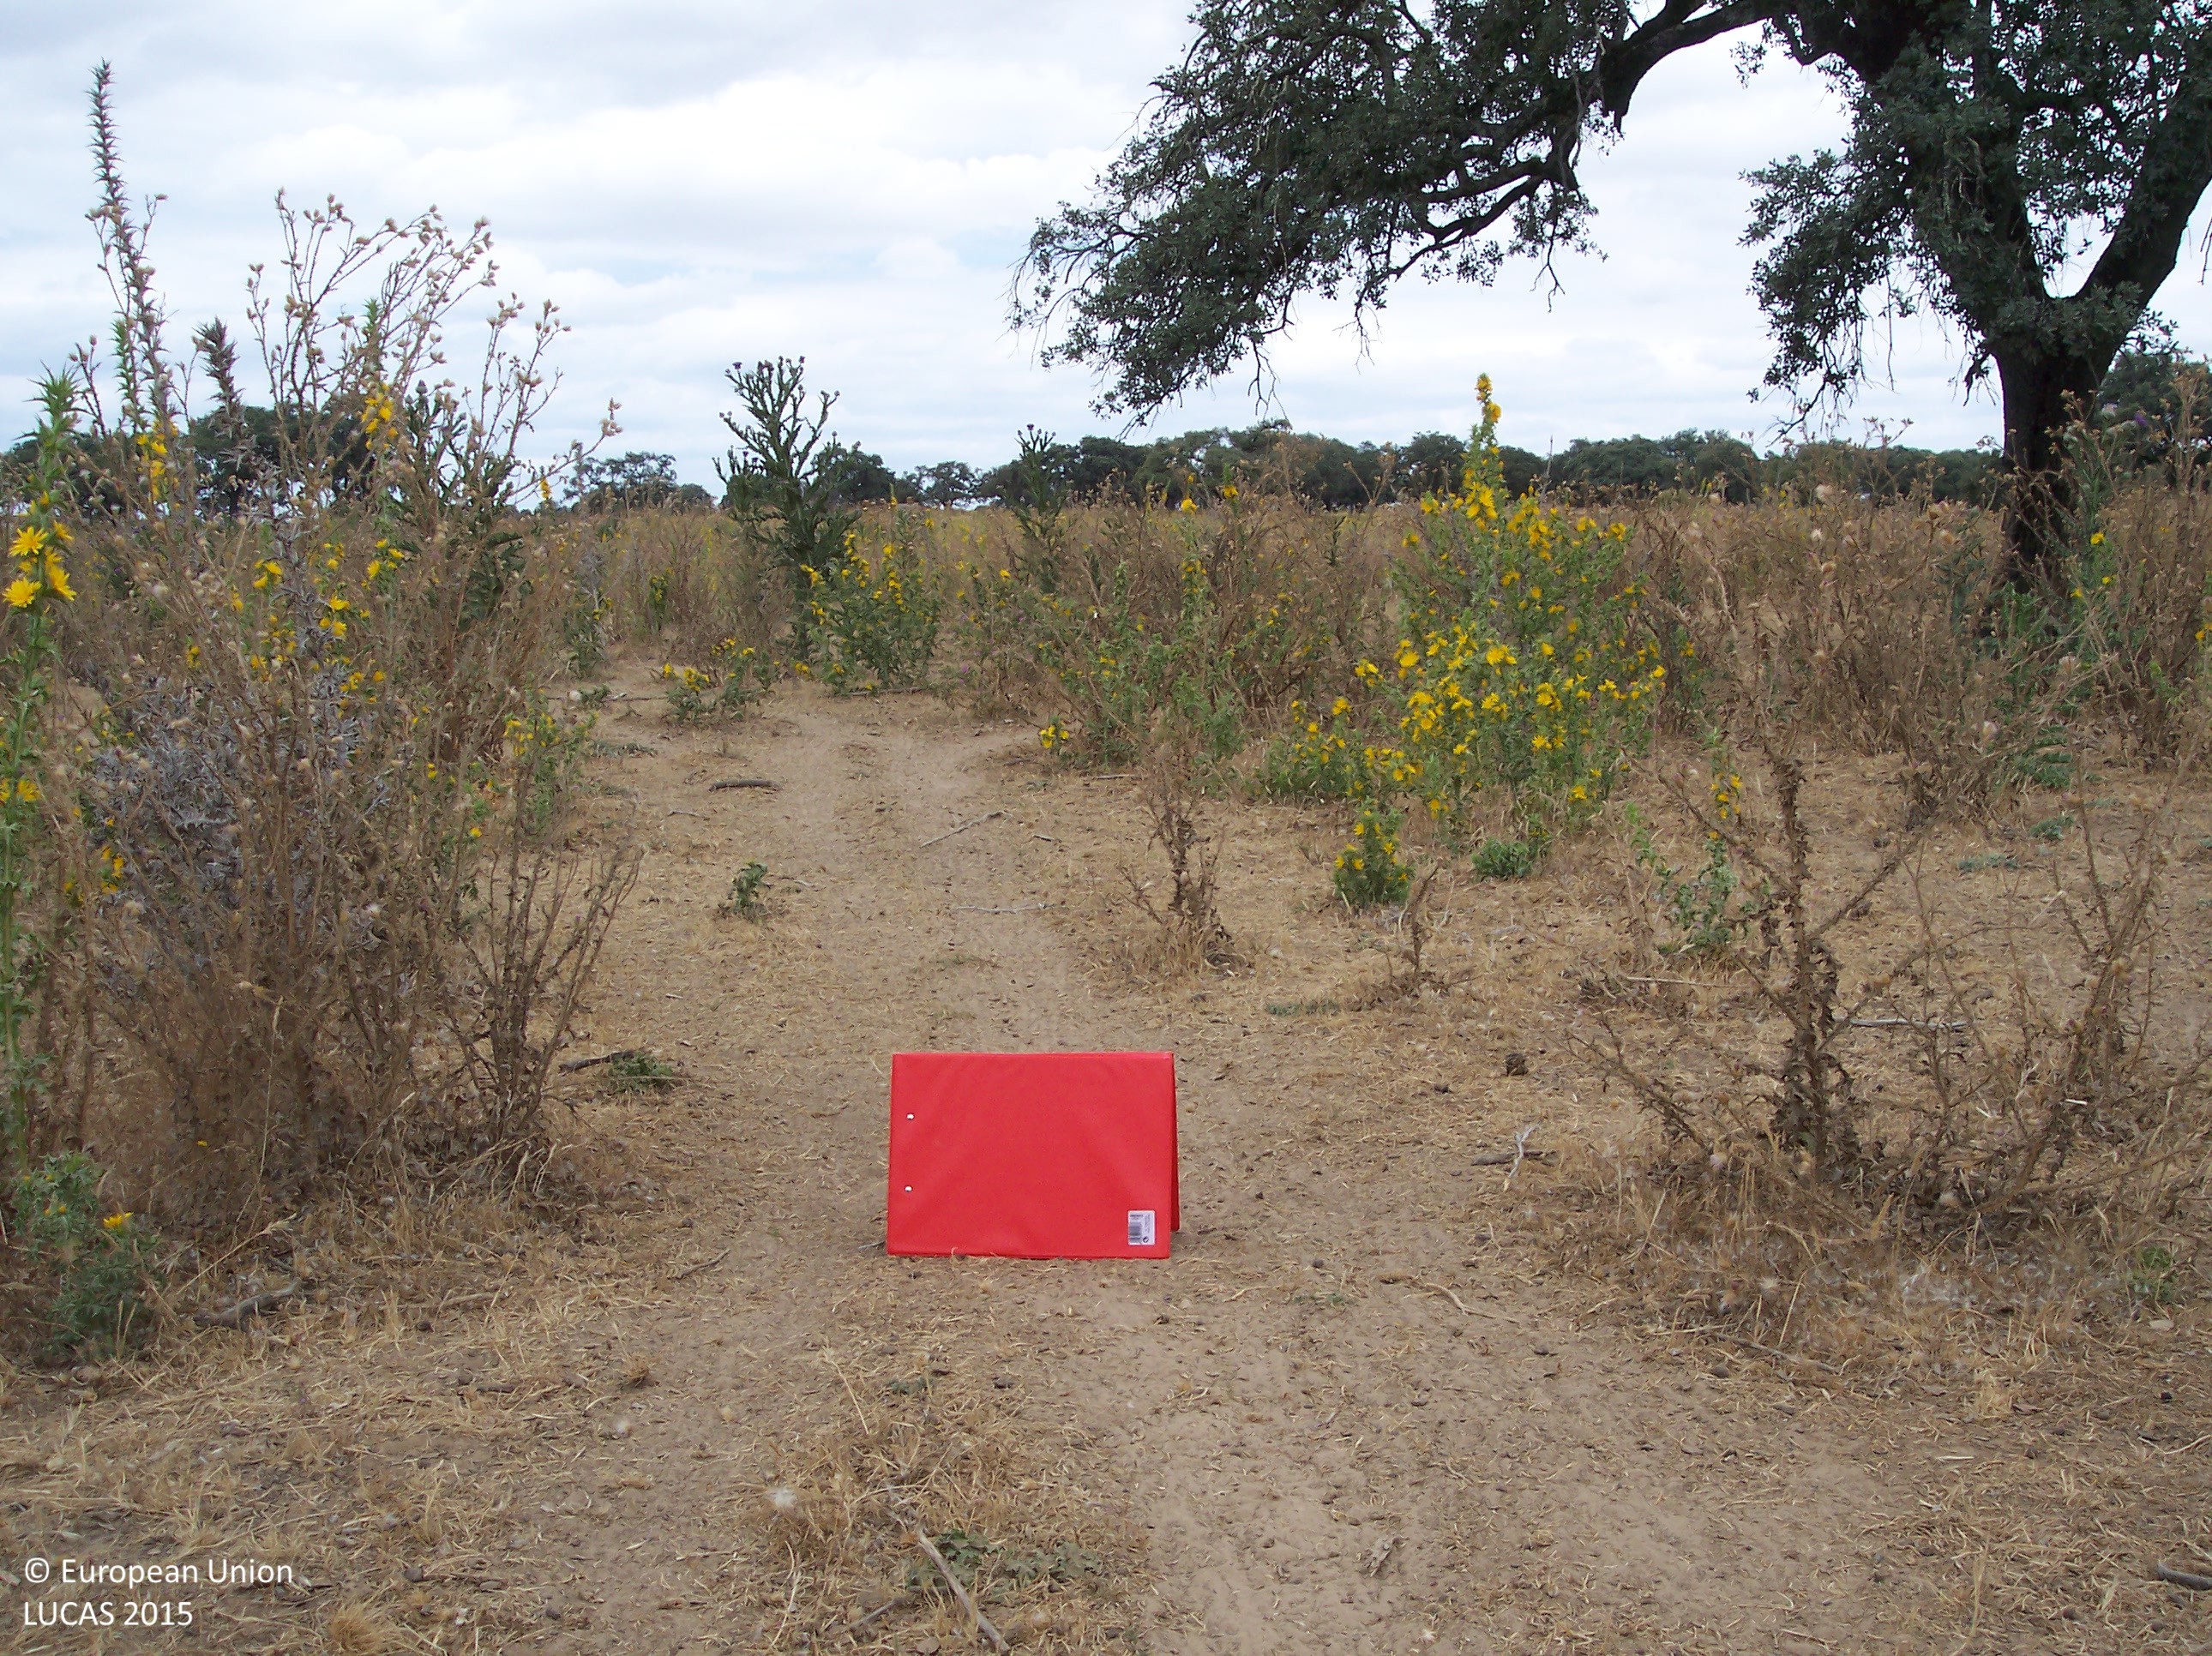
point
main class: Shrubland
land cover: Shrubland with sparse tree cover
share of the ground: 25 - 50 %
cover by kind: unconsolidated bare surface 60 %, shrubs 20 %, herbaceous plants 15 %, broadleaved forest trees 5 %
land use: Agriculture (excluding fallow land and kitchen gardens)
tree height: > 5 m
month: June
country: ES
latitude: 37.3273
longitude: -6.4049
